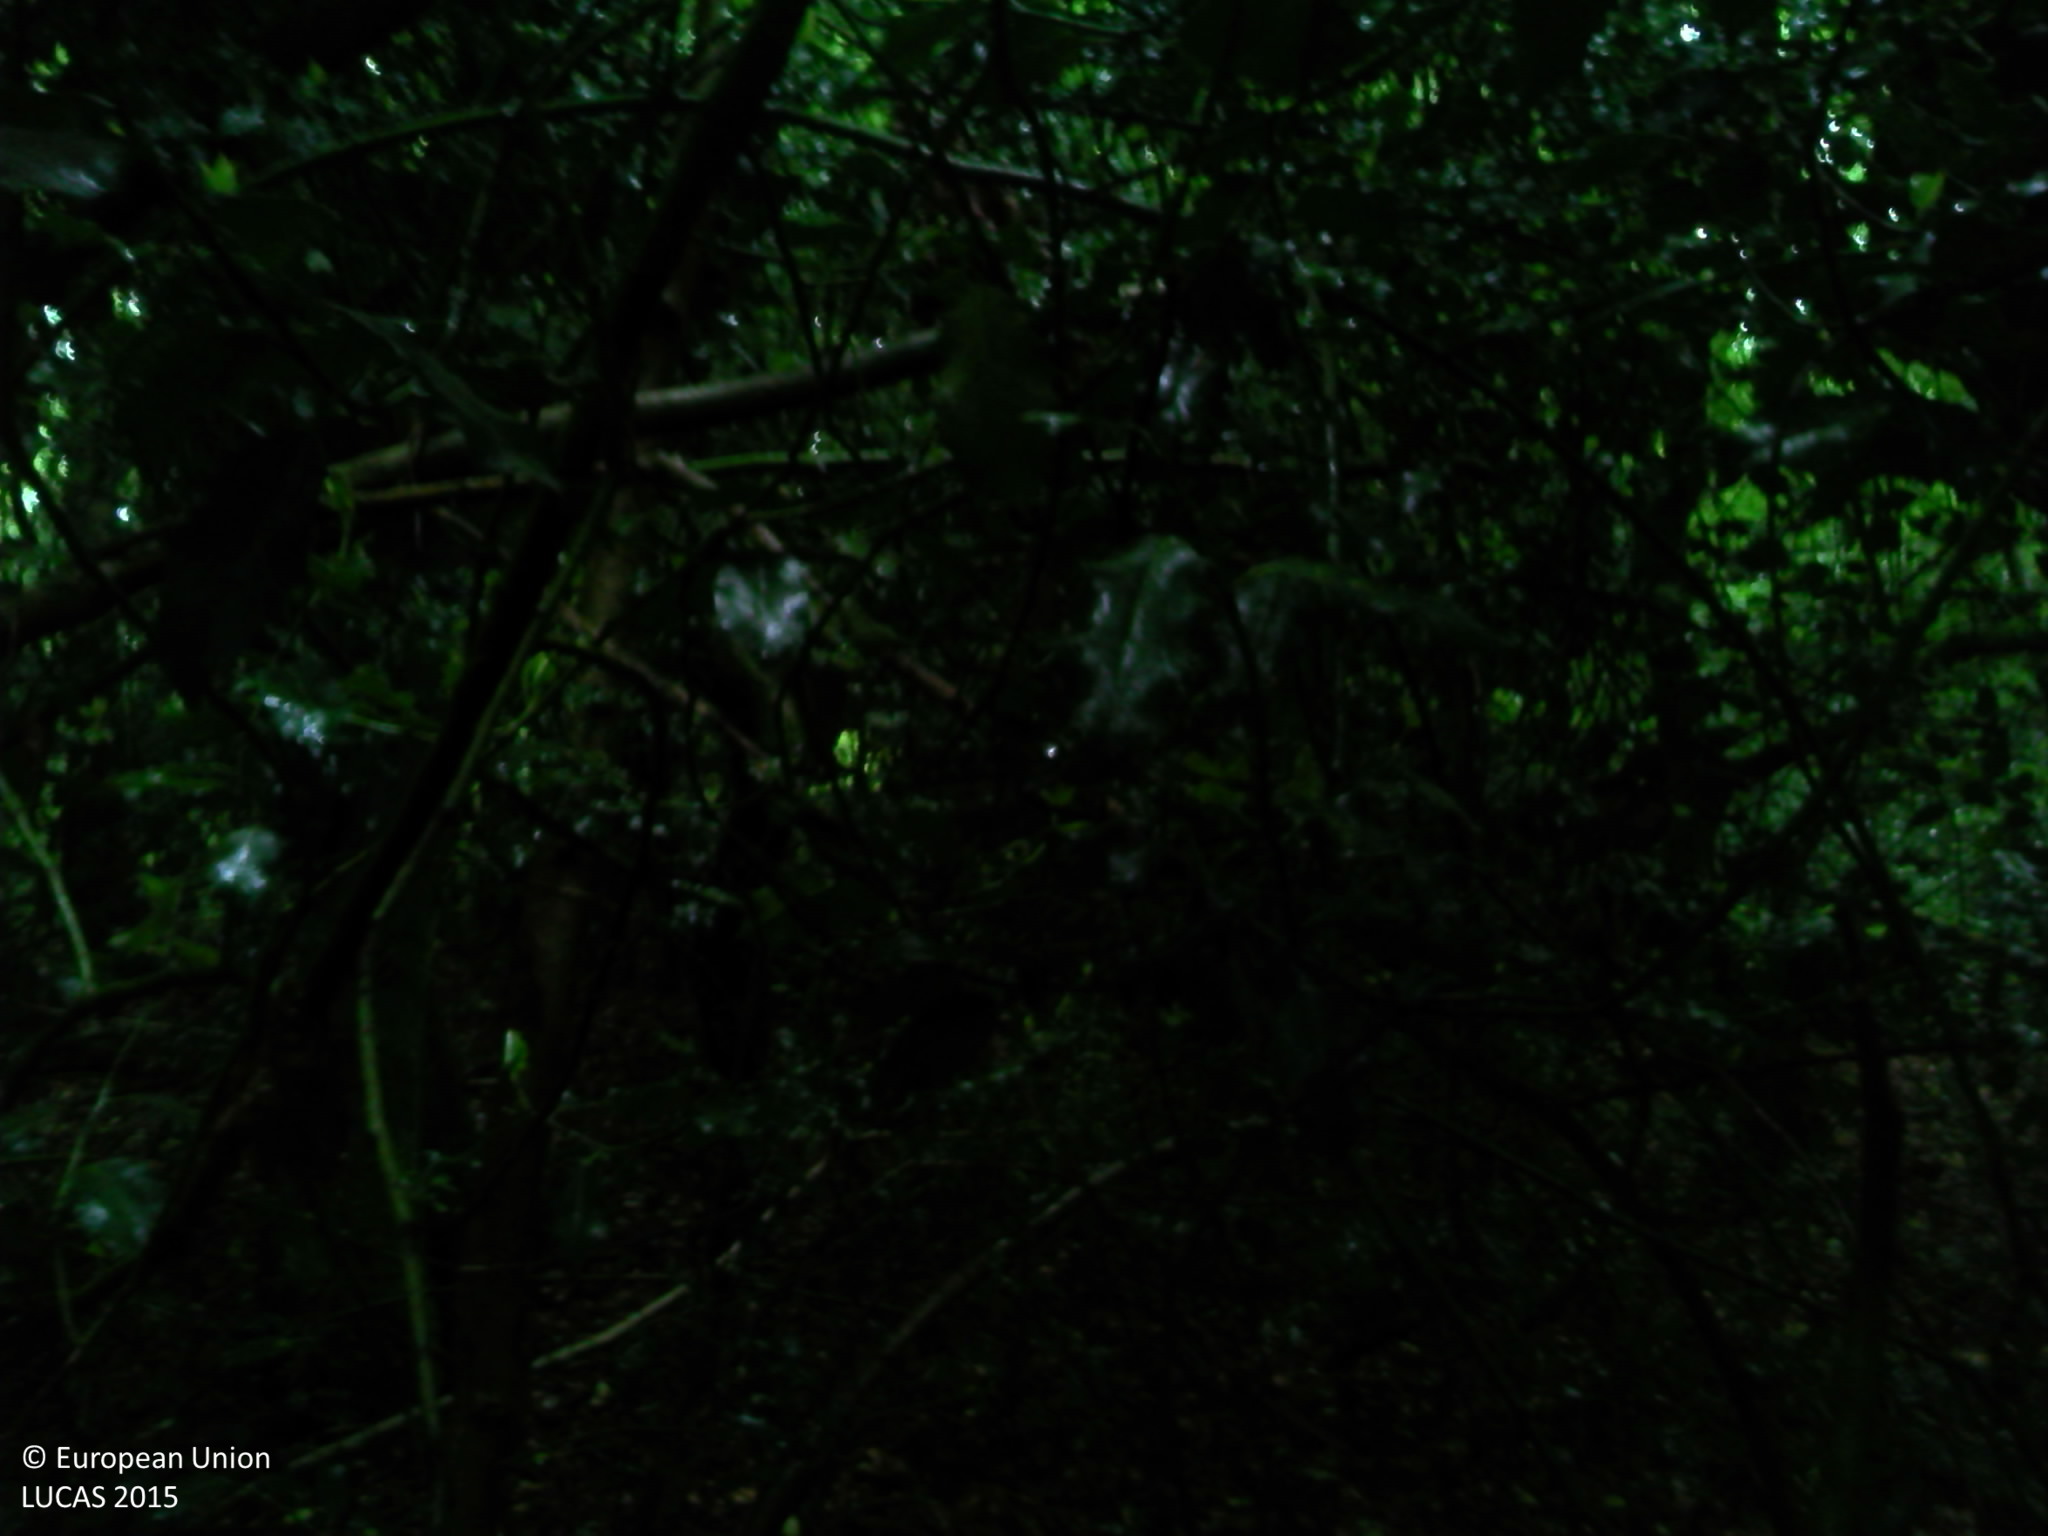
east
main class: Woodland
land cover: Broadleaved woodland
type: acidophilous oak and oak-birch forest
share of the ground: > 75 %
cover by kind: broadleaved forest trees 75 %, coniferous forest trees 15 %, herbaceous plants 10 %
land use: Forestry
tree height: > 5 m
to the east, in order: Broadleaved woodland; Rivers and streams; Broadleaved woodland; Fences; Broadleaved woodland; Grassland with sparse tree/shrub cover
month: June
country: FR
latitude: 49.5960
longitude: -1.7156
